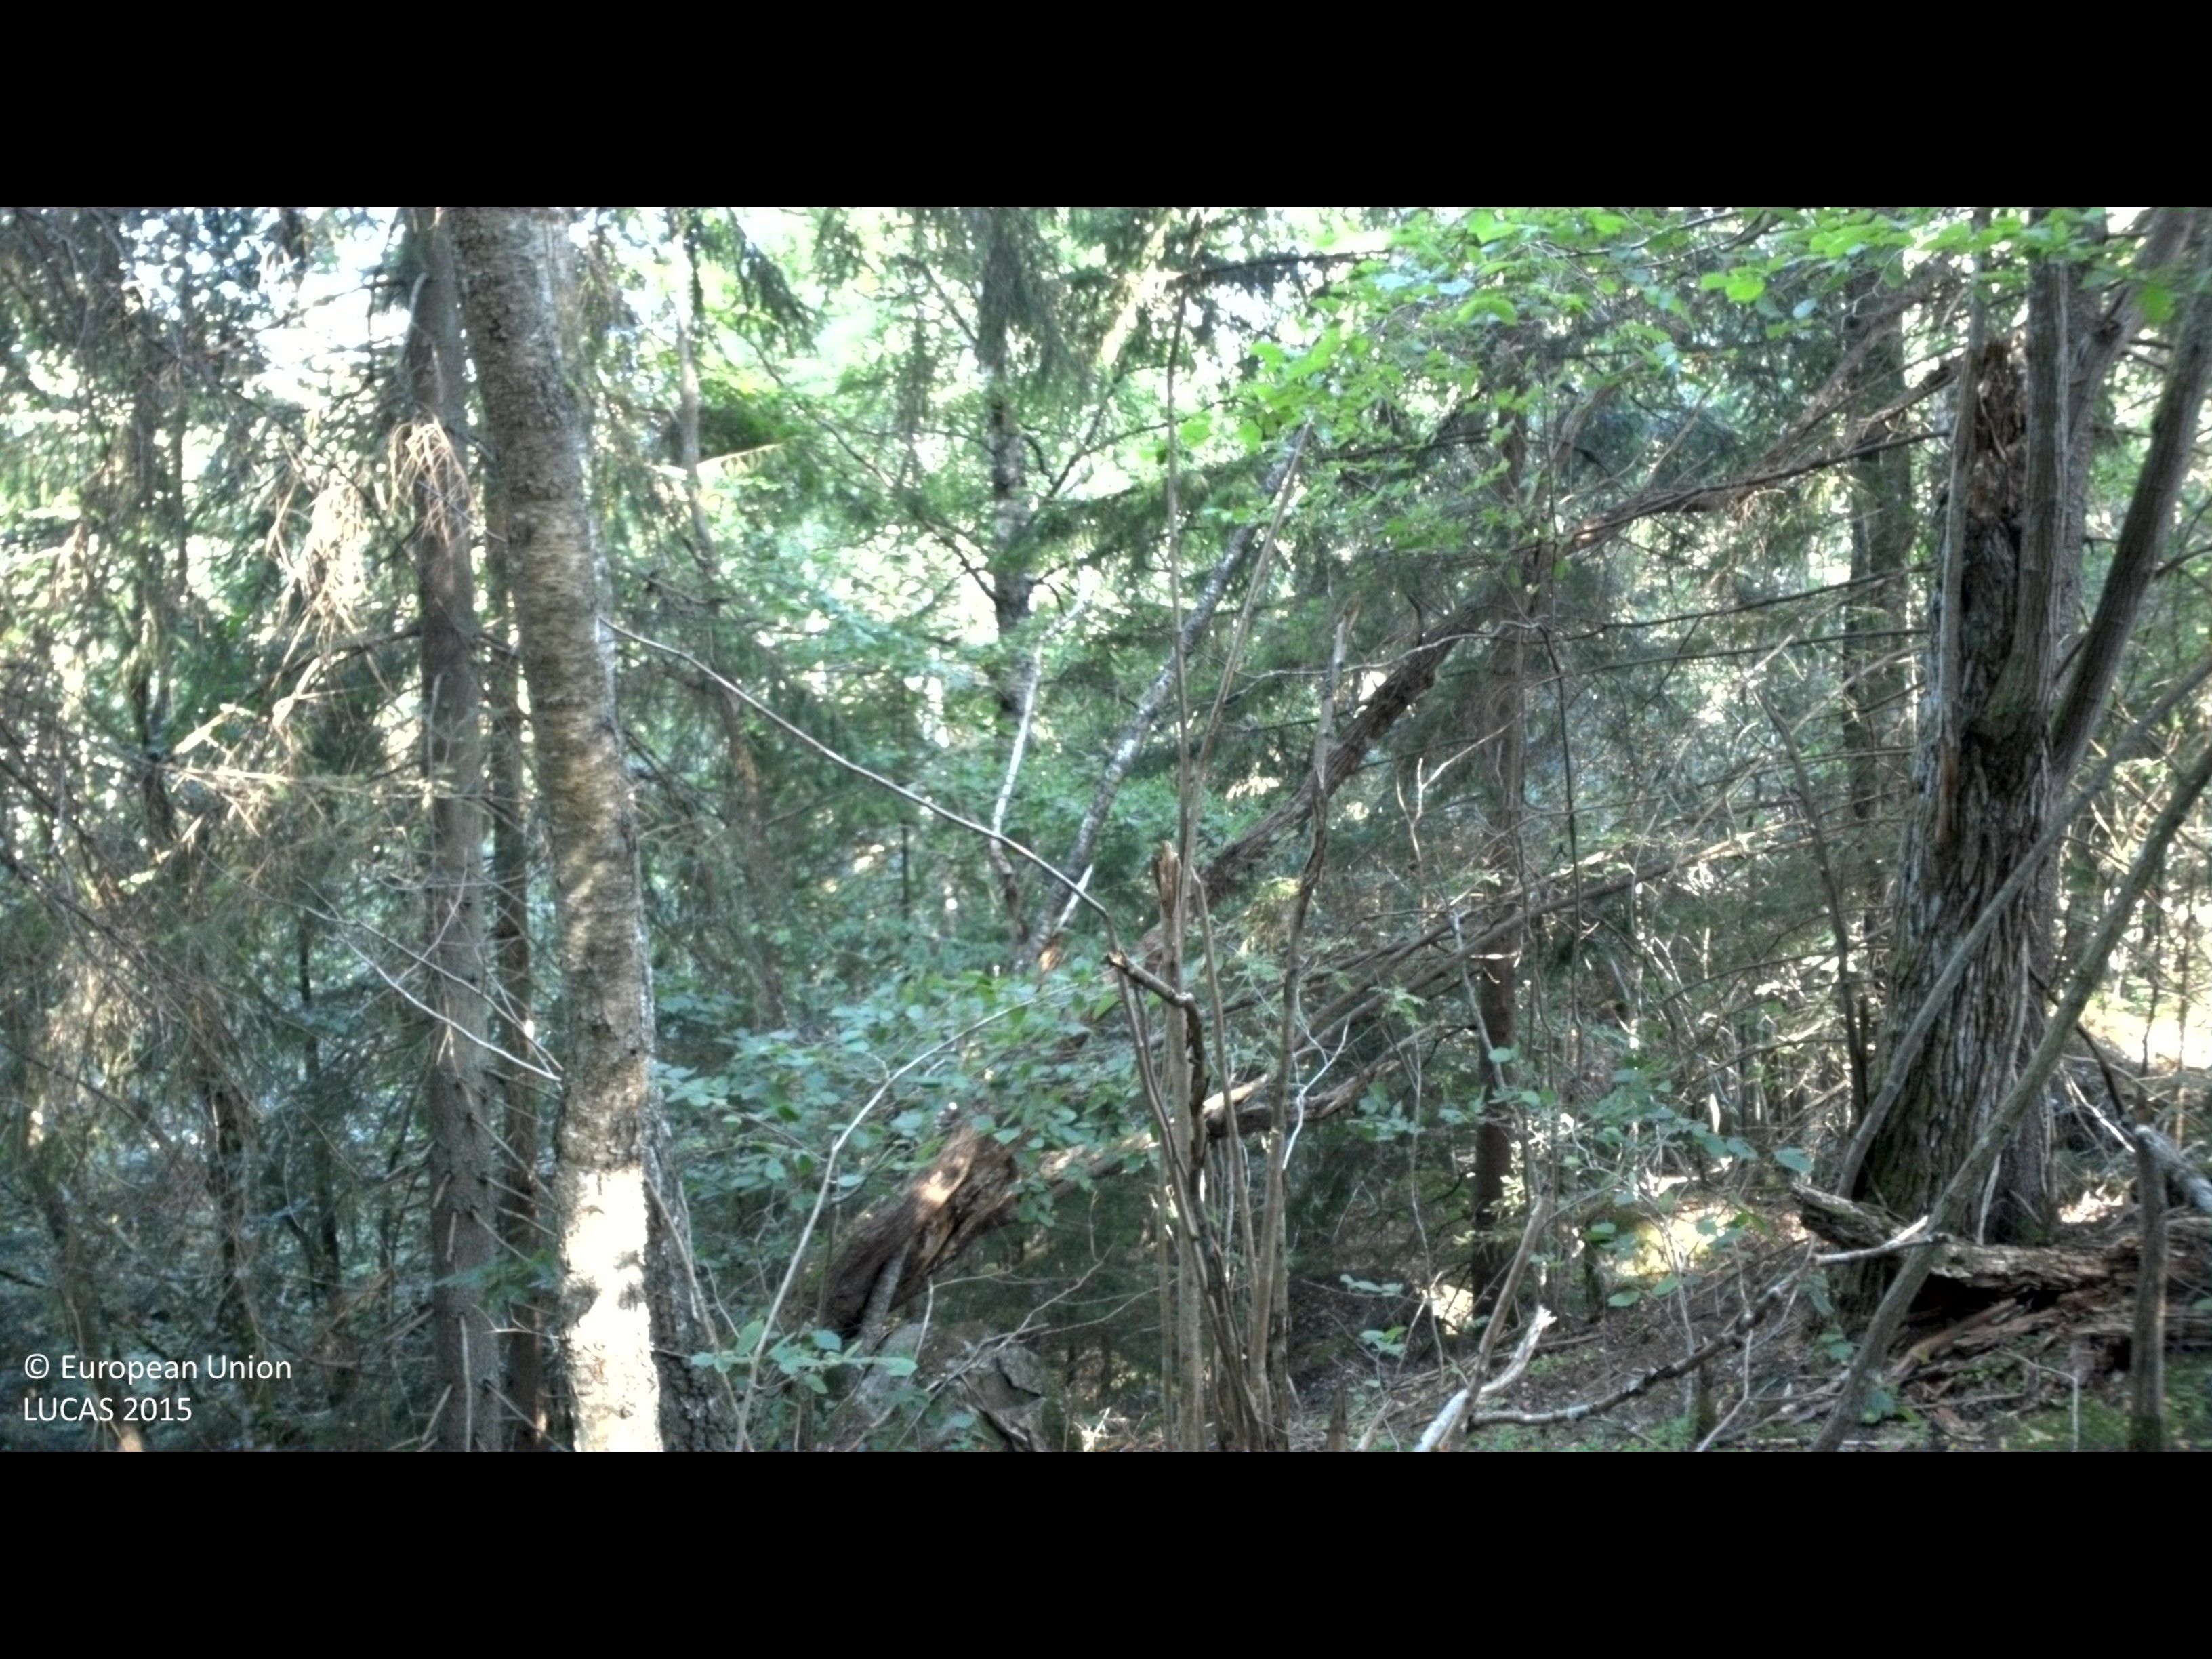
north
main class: Woodland
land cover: Spruce dominated mixed woodland
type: hemiboreal forest and nemoral coniferous forest and mixed broadleaved-coniferous forest
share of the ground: 50 - 75 %
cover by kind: coniferous forest trees 55 %, broadleaved forest trees 20 %, shrubs 10 %, lichens and mosses 10 %, unconsolidated bare surface 5 %
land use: Forestry
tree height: > 5 m
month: August
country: SE
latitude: 56.3236
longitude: 14.5417
